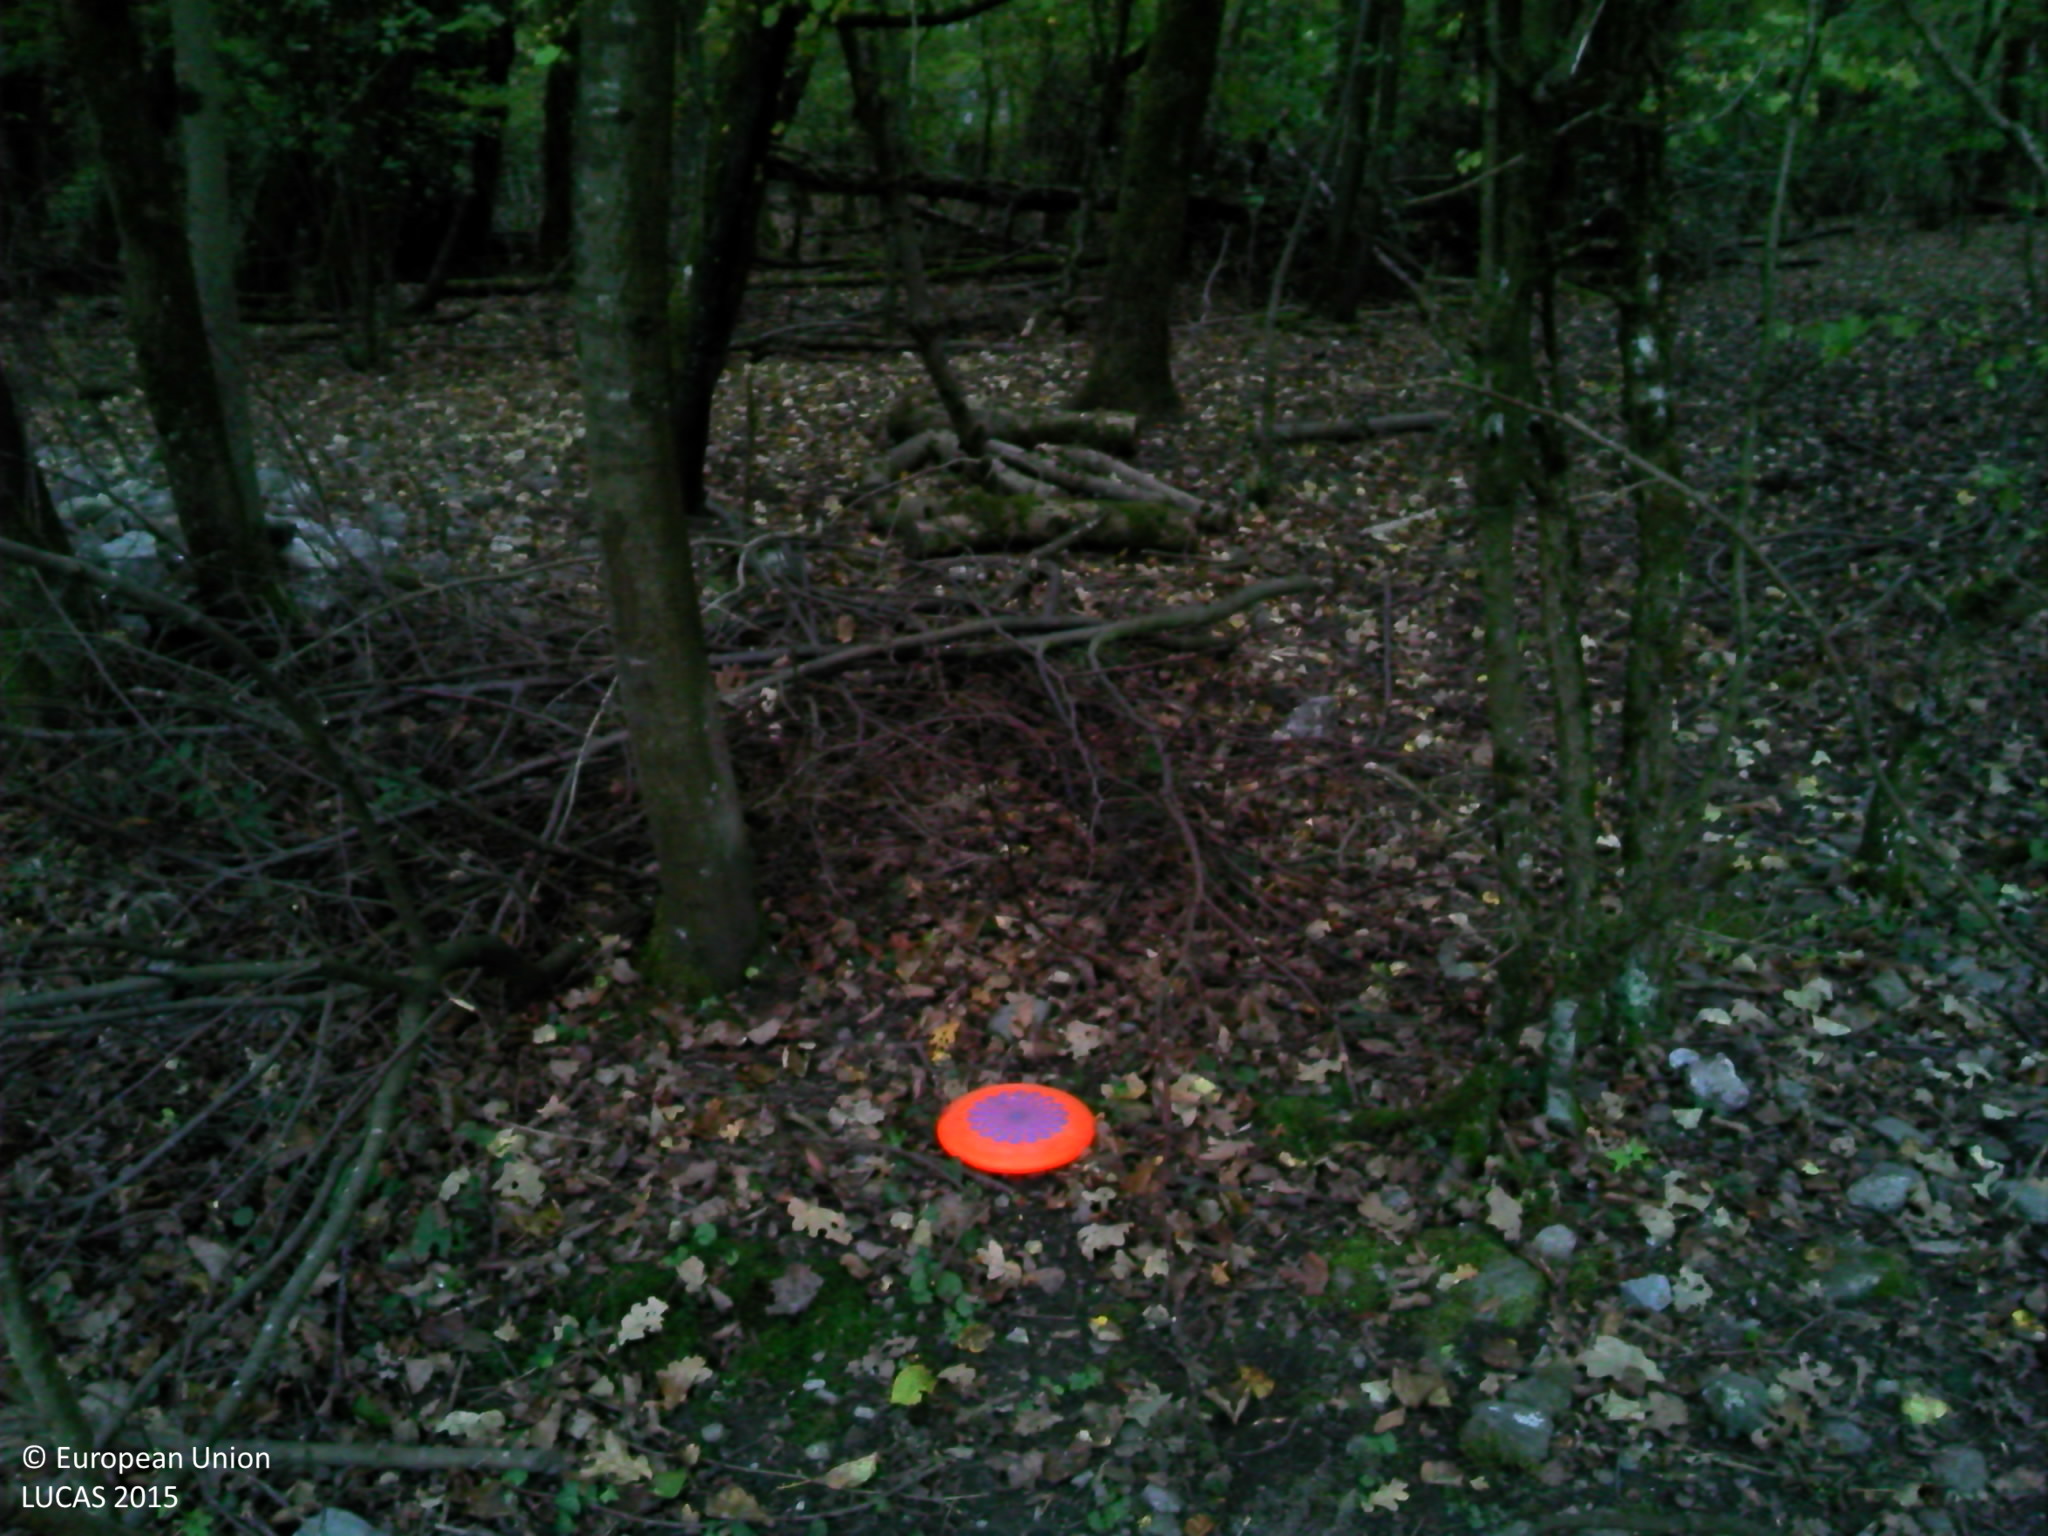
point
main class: Woodland
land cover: Broadleaved woodland
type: mesophytic deciduous forest
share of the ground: > 75 %
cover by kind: broadleaved forest trees 95 %, consolidated bare surface 5 %
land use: Forestry
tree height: > 5 m
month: October
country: FR
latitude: 45.4751
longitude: 6.2822
